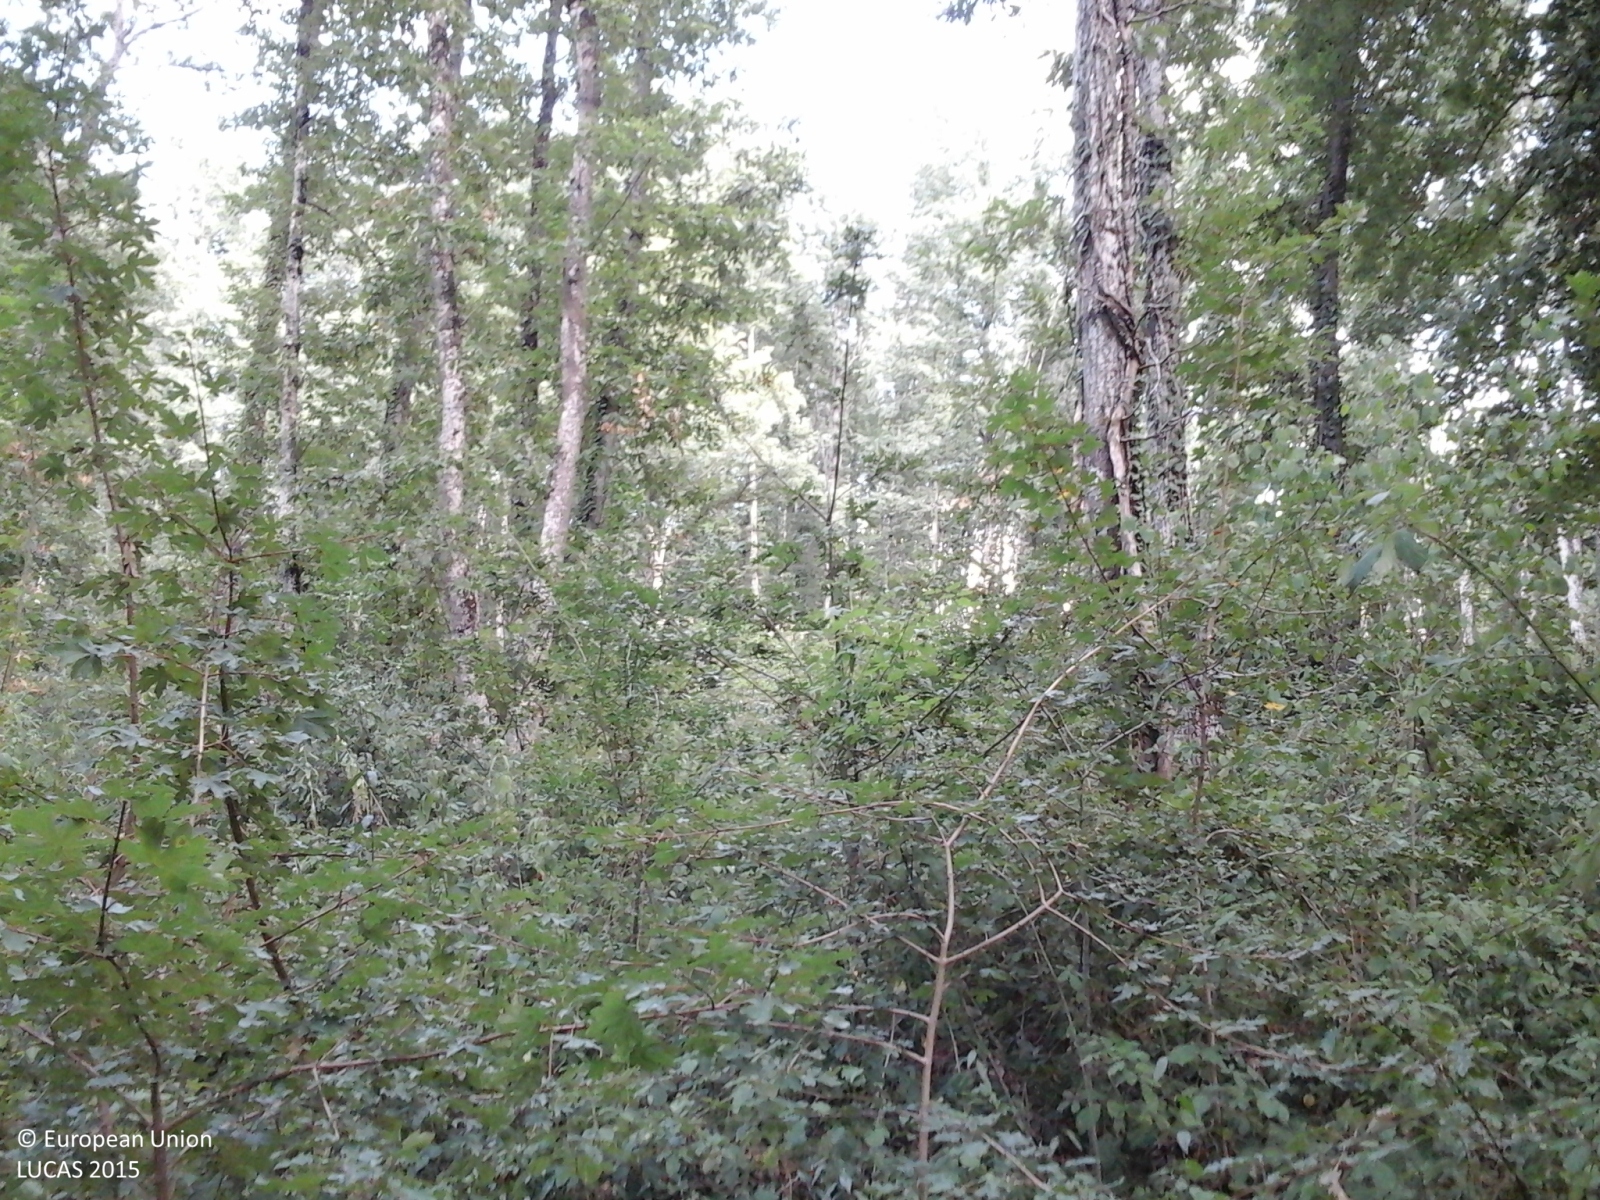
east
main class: Woodland
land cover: Broadleaved woodland
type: thermophilous deciduous forest
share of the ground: > 75 %
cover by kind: broadleaved forest trees 70 %, shrubs 20 %, herbaceous plants 10 %
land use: Forestry
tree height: > 5 m
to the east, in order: Broadleaved woodland; Paved roads, cycling and walking lanes; Broadleaved woodland
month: August
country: IT
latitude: 41.7135
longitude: 14.2759
